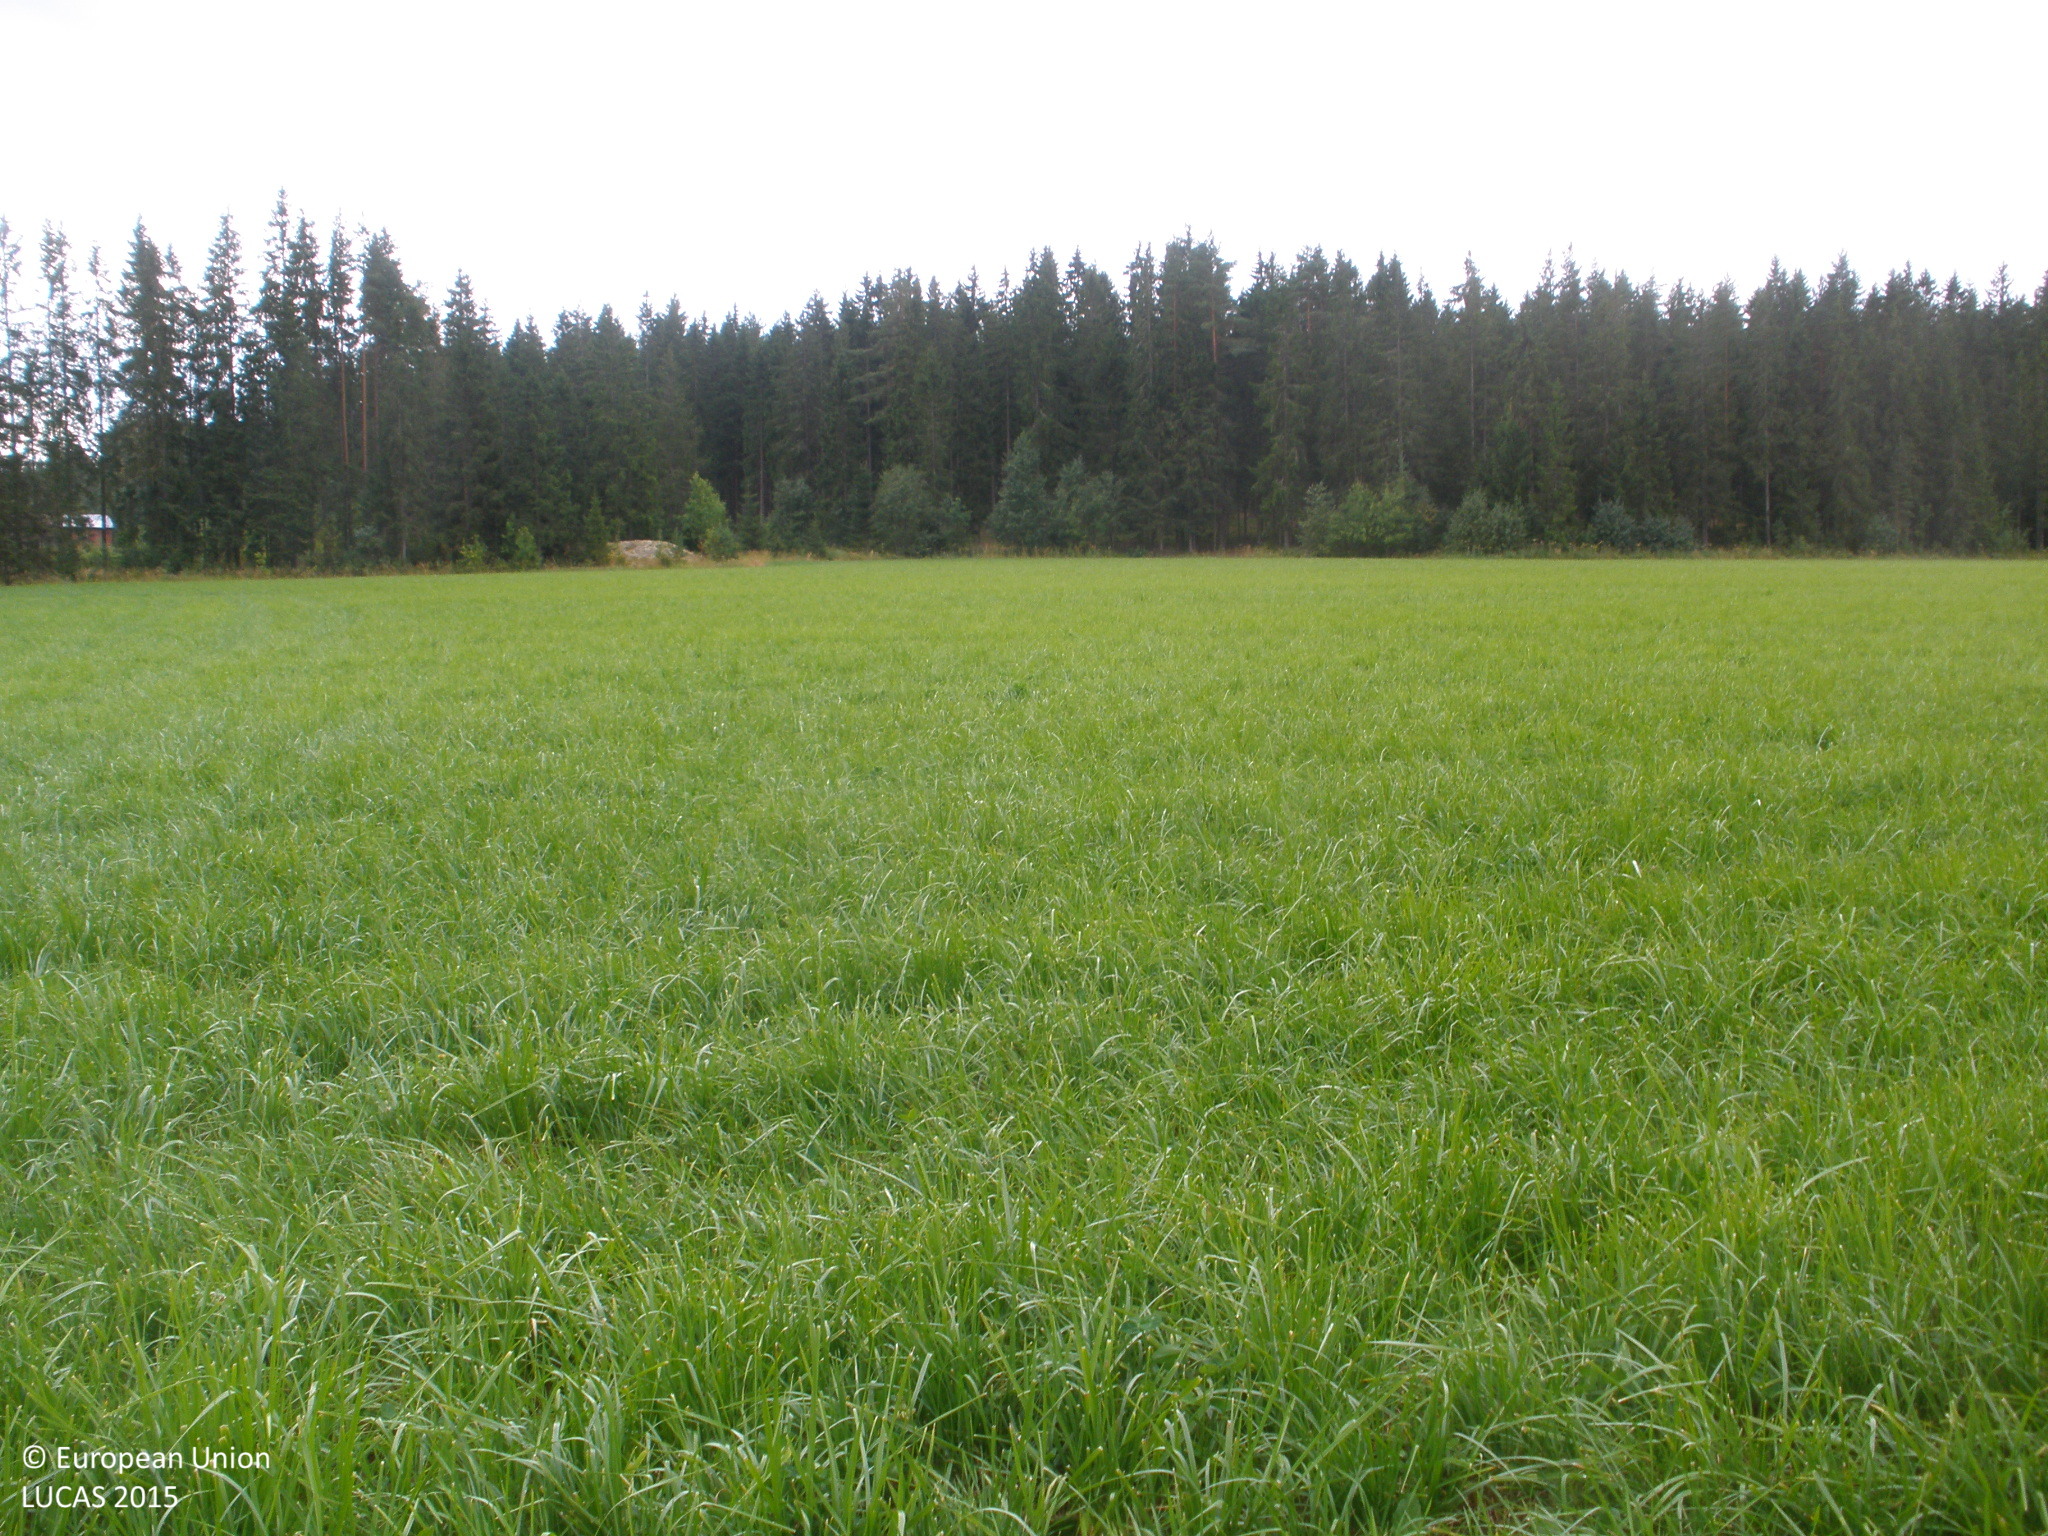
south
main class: Cropland
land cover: Temporary grasslands
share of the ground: > 75 %
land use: Agriculture (excluding fallow land and kitchen gardens)
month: August
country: FI
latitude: 60.5715
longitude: 23.4967
